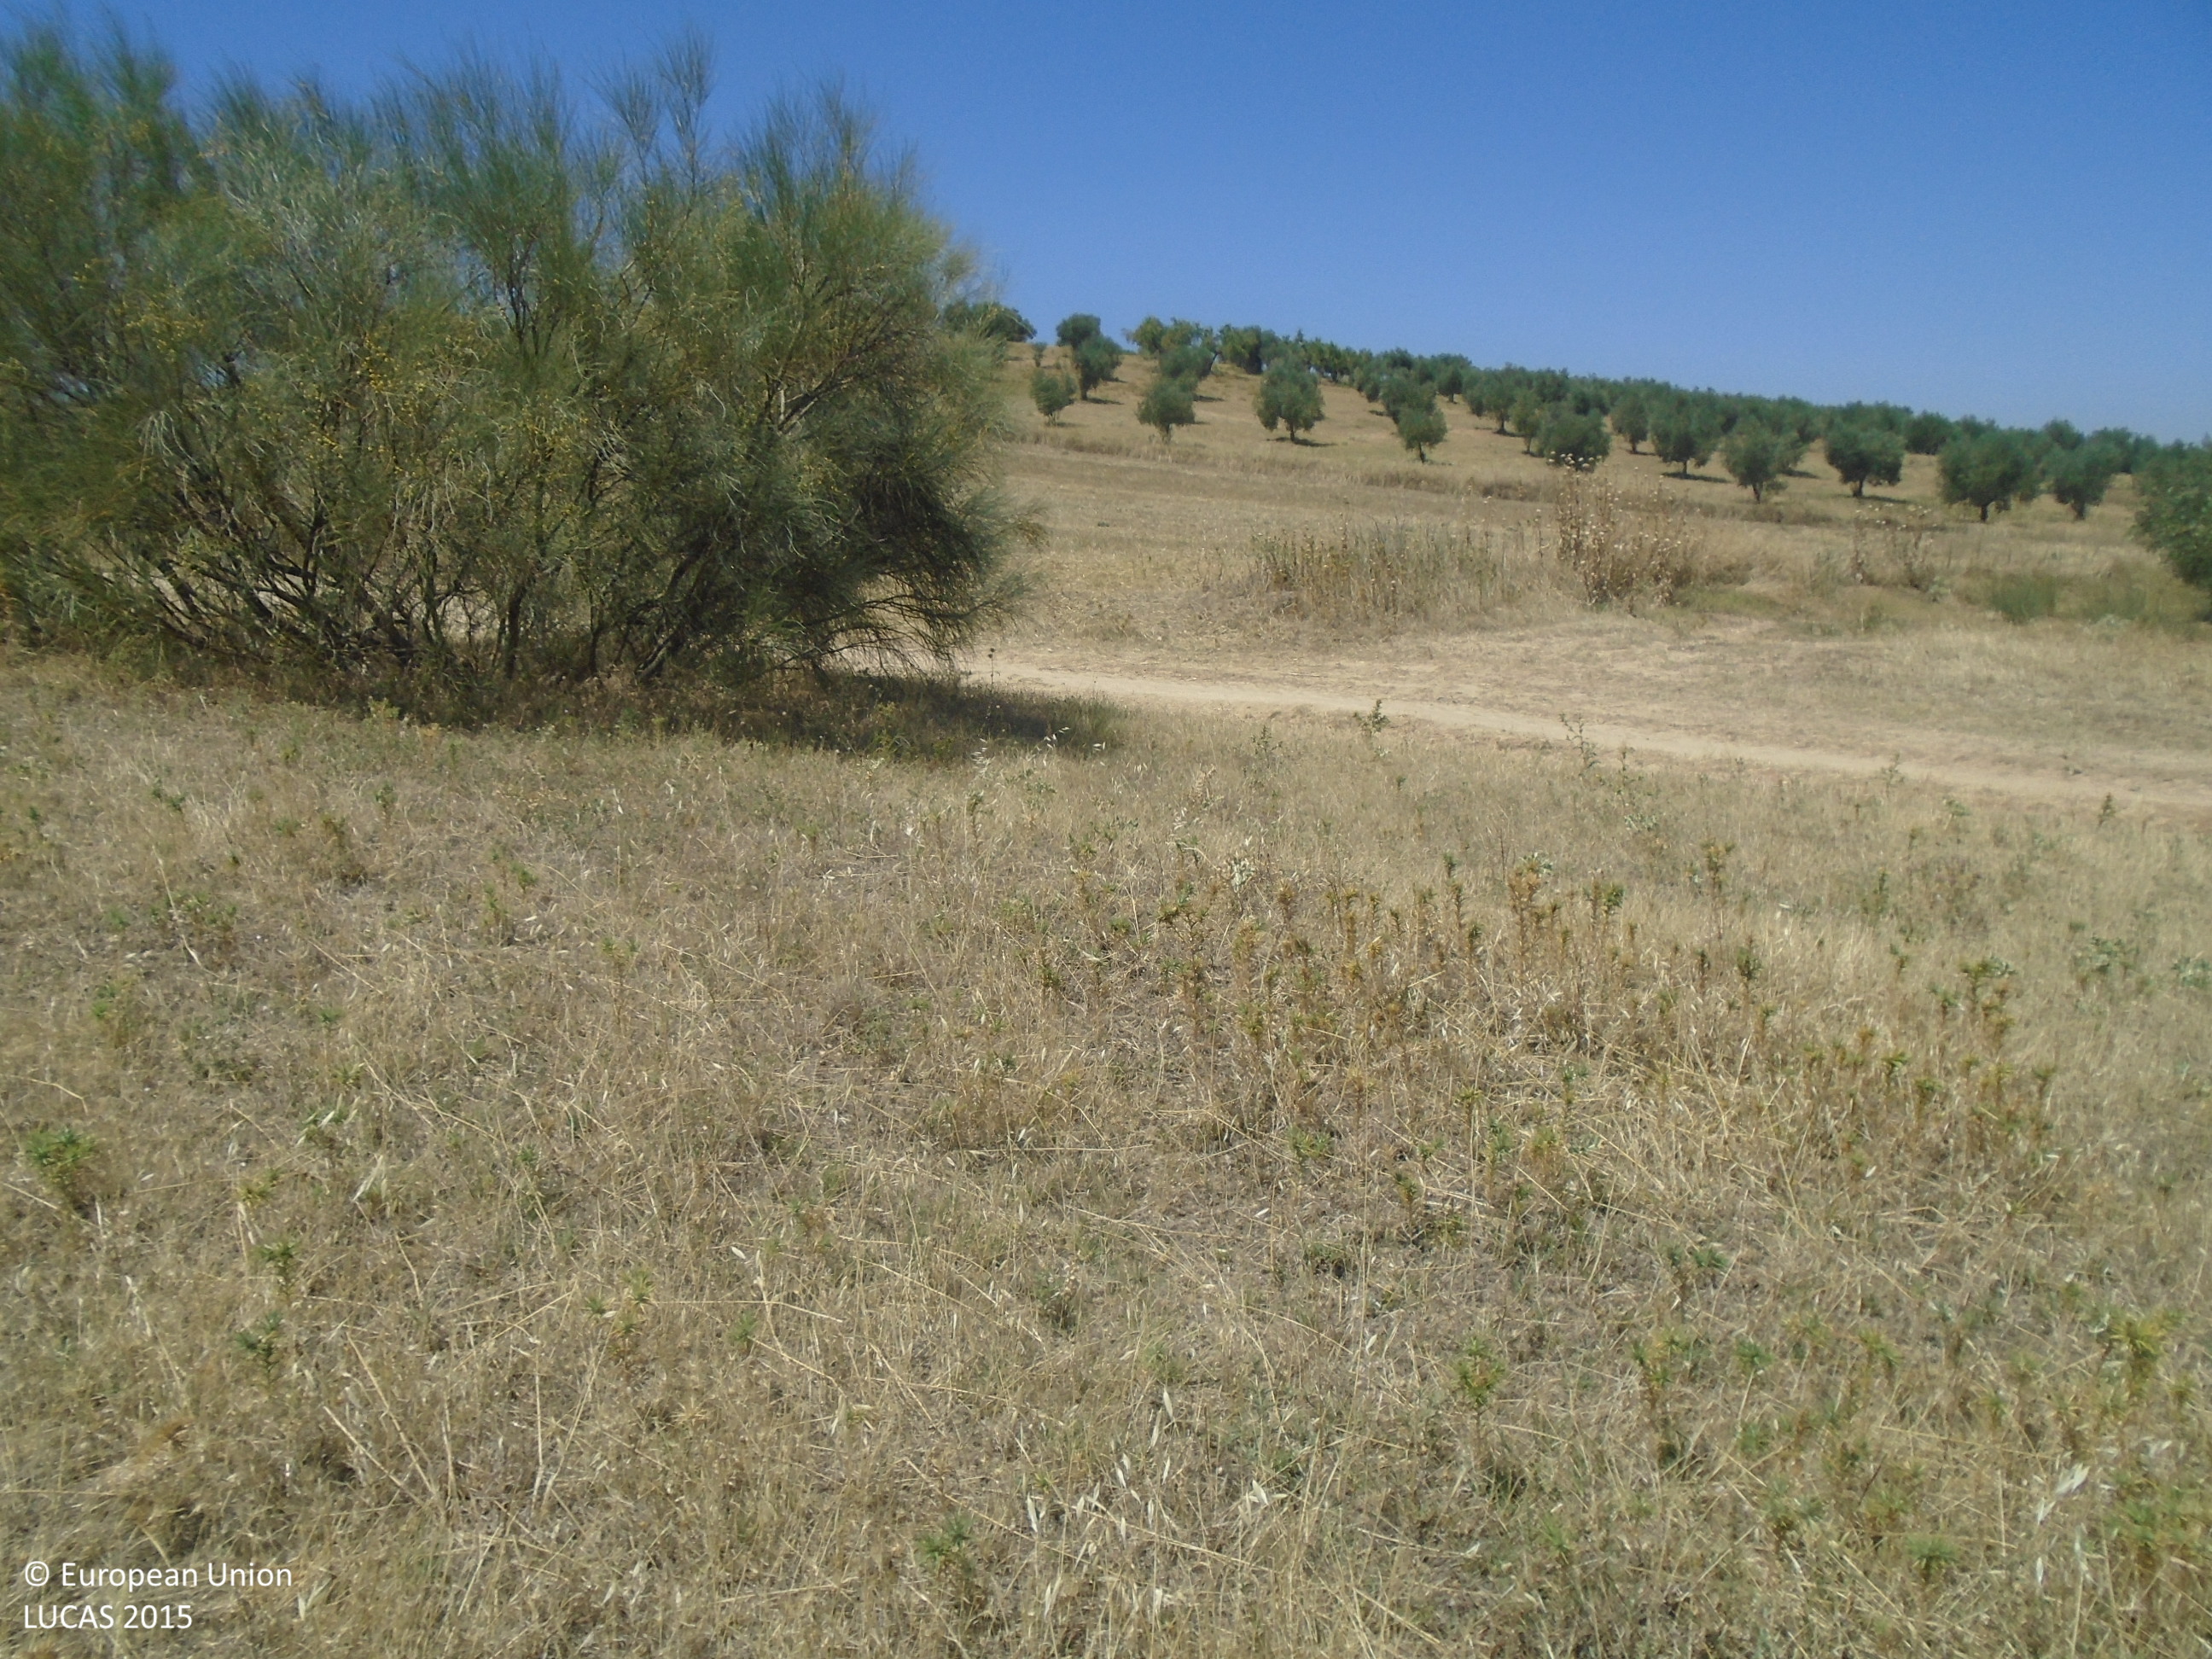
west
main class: Cropland
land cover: Common wheat
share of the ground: > 75 %
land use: Agriculture (excluding fallow land and kitchen gardens)
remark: Harvested field
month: July
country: ES
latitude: 39.7784
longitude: -4.9331
